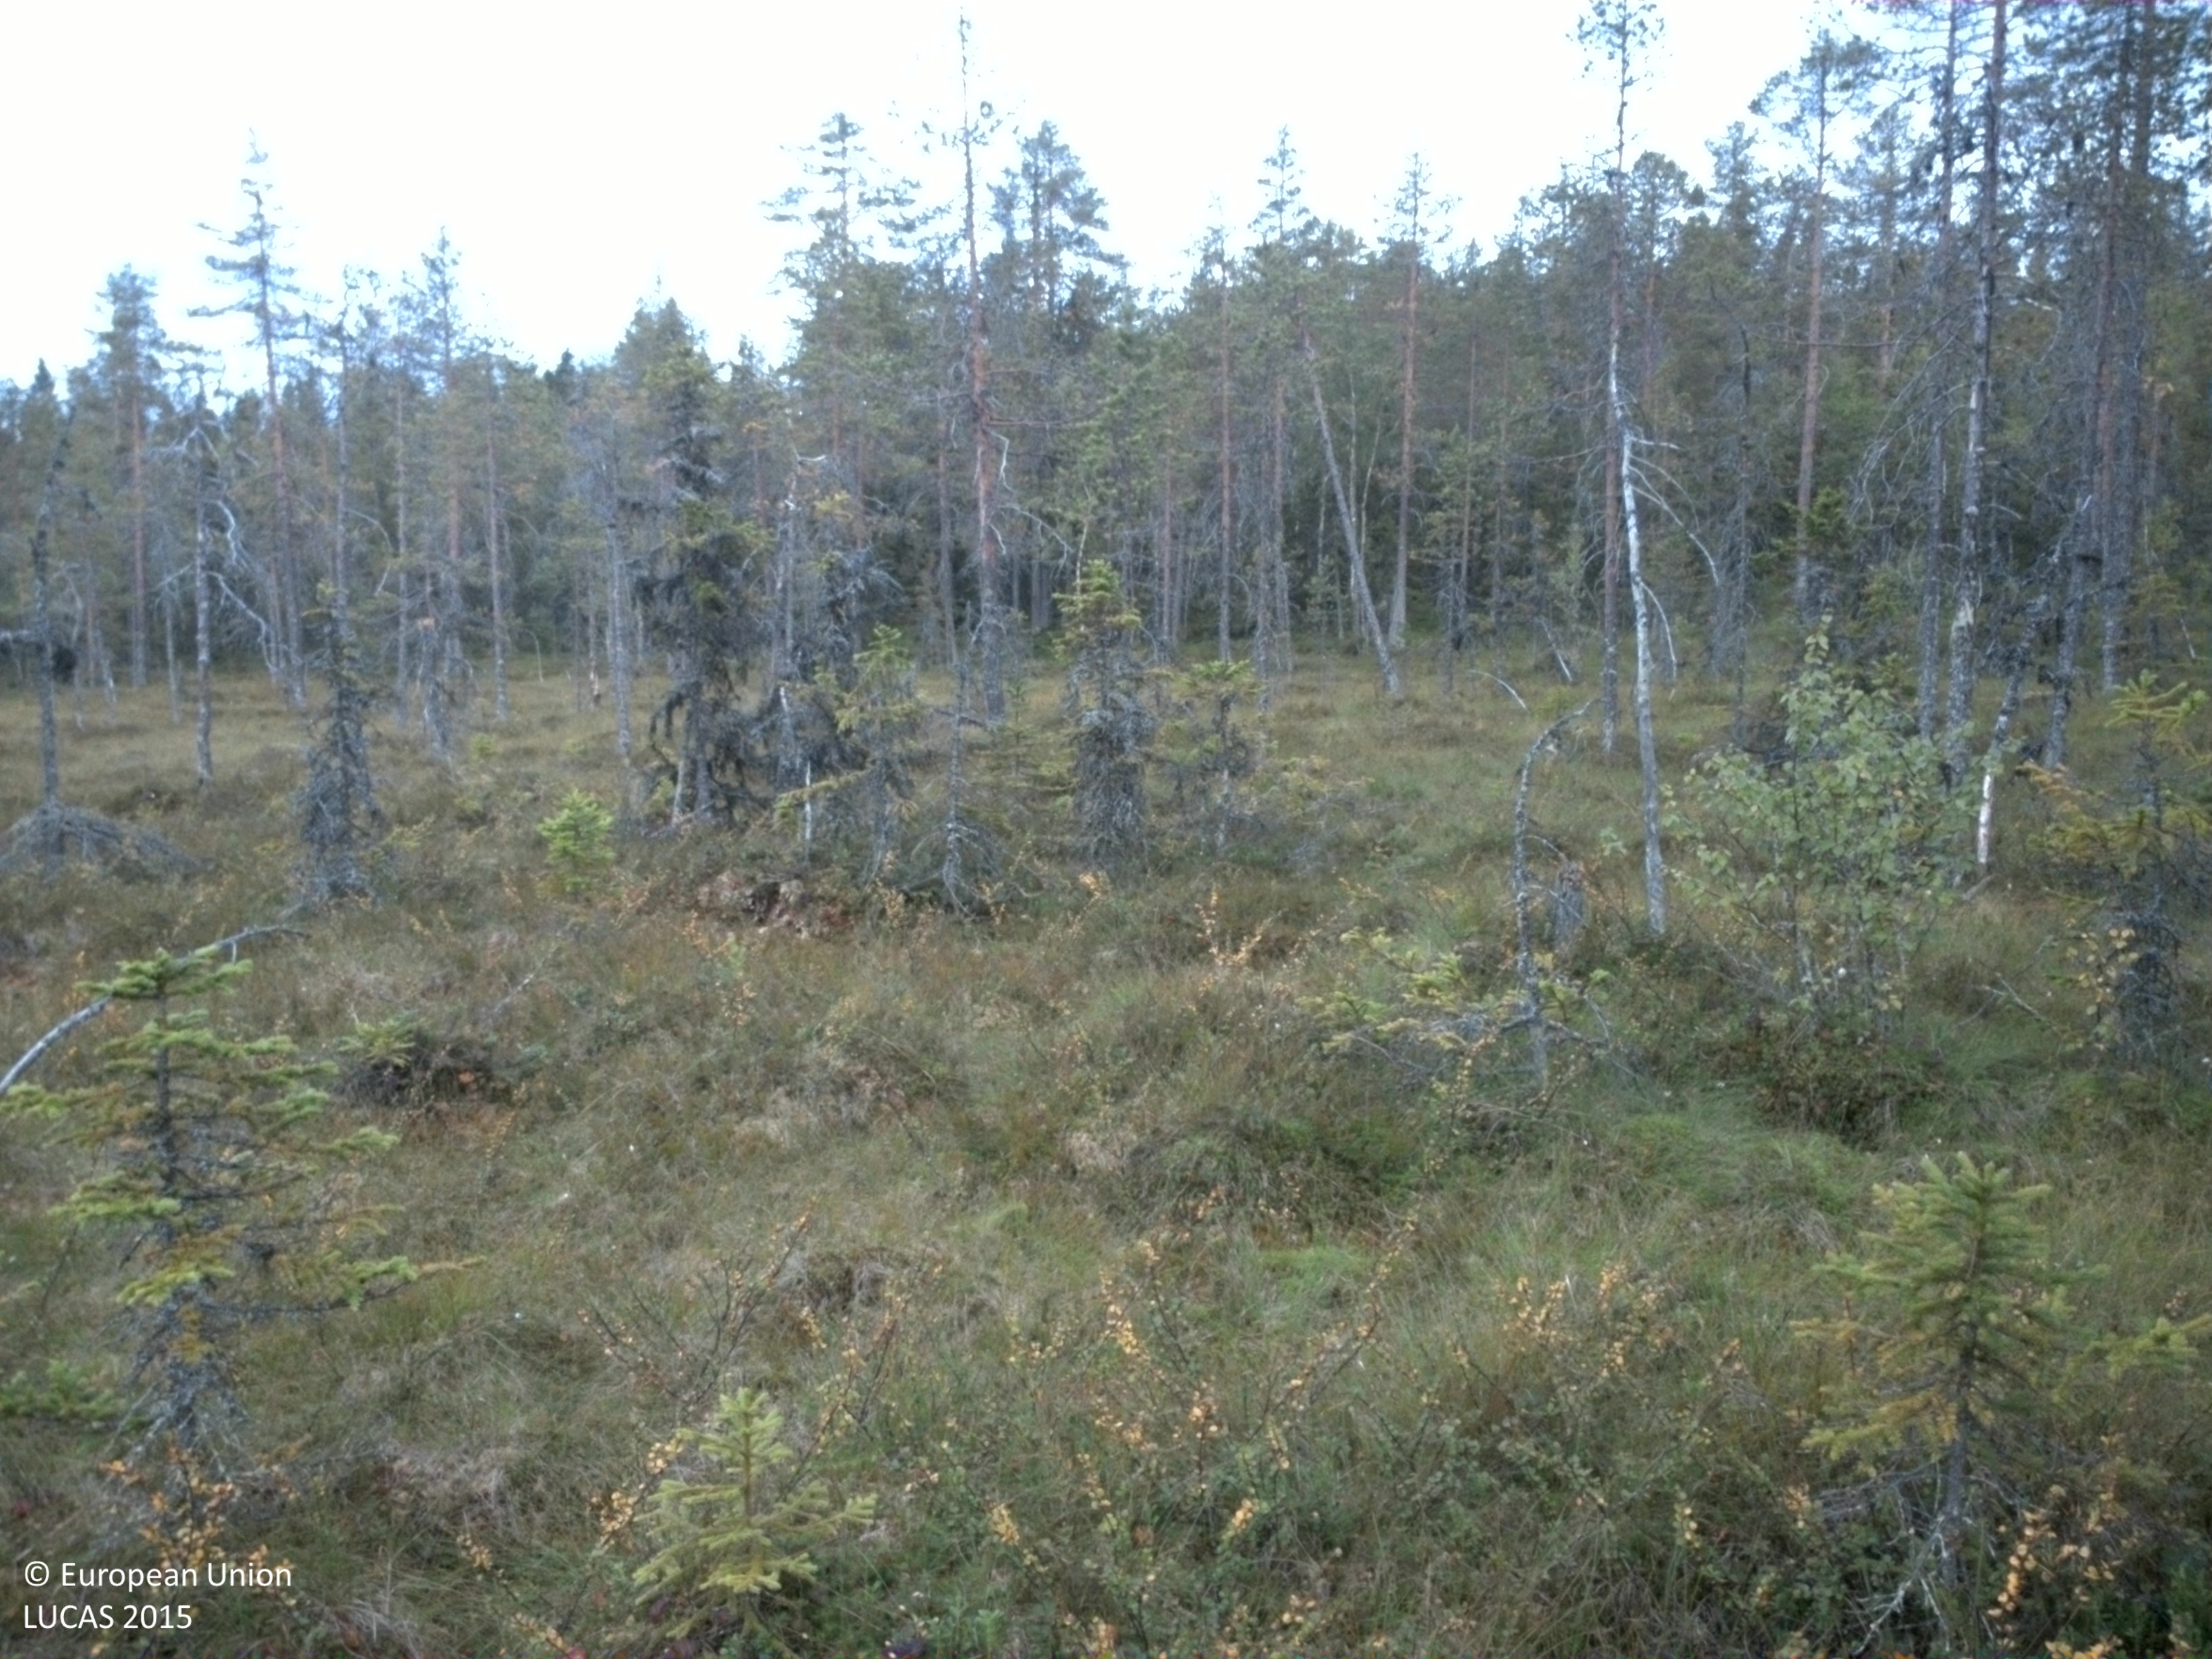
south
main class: Woodland
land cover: Other mixed woodland
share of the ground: 25 - 50 %
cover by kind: shrubs 25 %, lichens and mosses 25 %, coniferous forest trees 20 %, broadleaved forest trees 15 %, herbaceous plants 15 %
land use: Forestry
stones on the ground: < 10 %
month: August
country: SE
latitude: 61.7793
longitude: 15.2720
